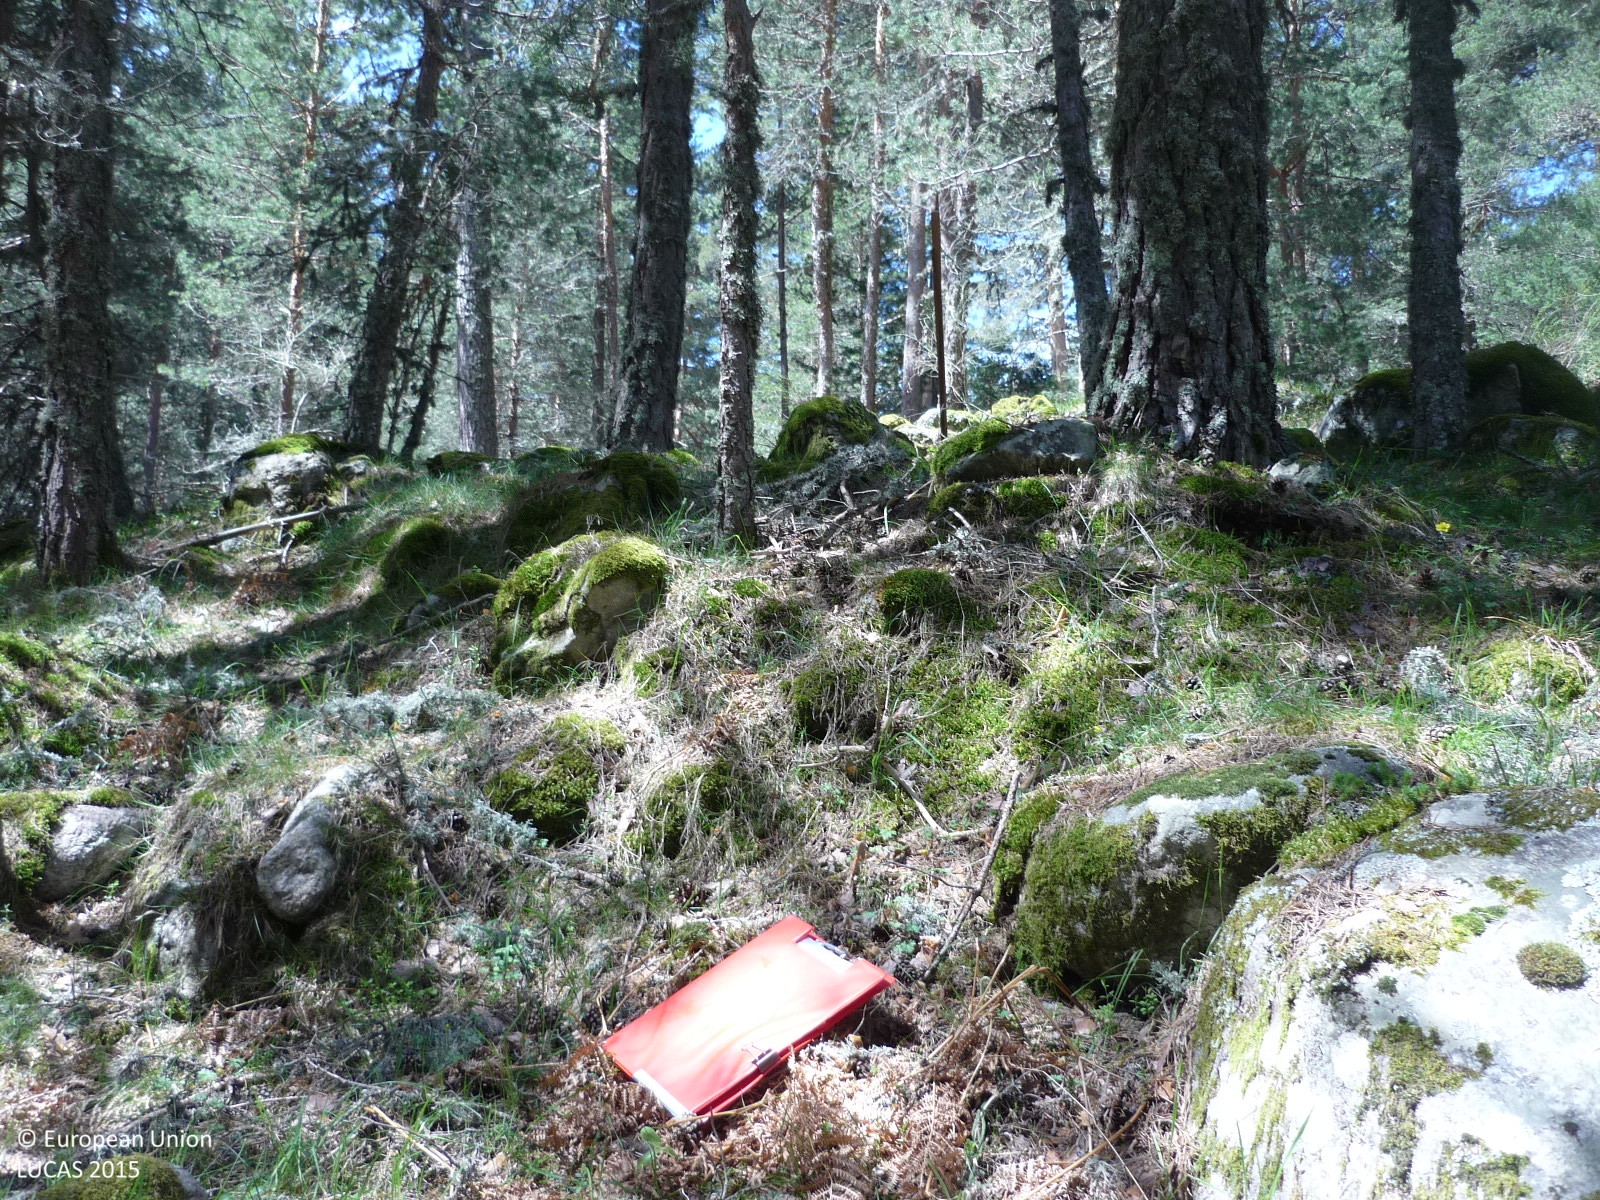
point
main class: Woodland
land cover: Pine dominated coniferous woodland
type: coniferous forest of the mediterranean region
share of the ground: > 75 %
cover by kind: coniferous forest trees 85 %, shrubs 10 %, herbaceous plants 5 %
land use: Forestry
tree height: > 5 m
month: May
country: ES
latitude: 40.8256
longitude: -3.9308
